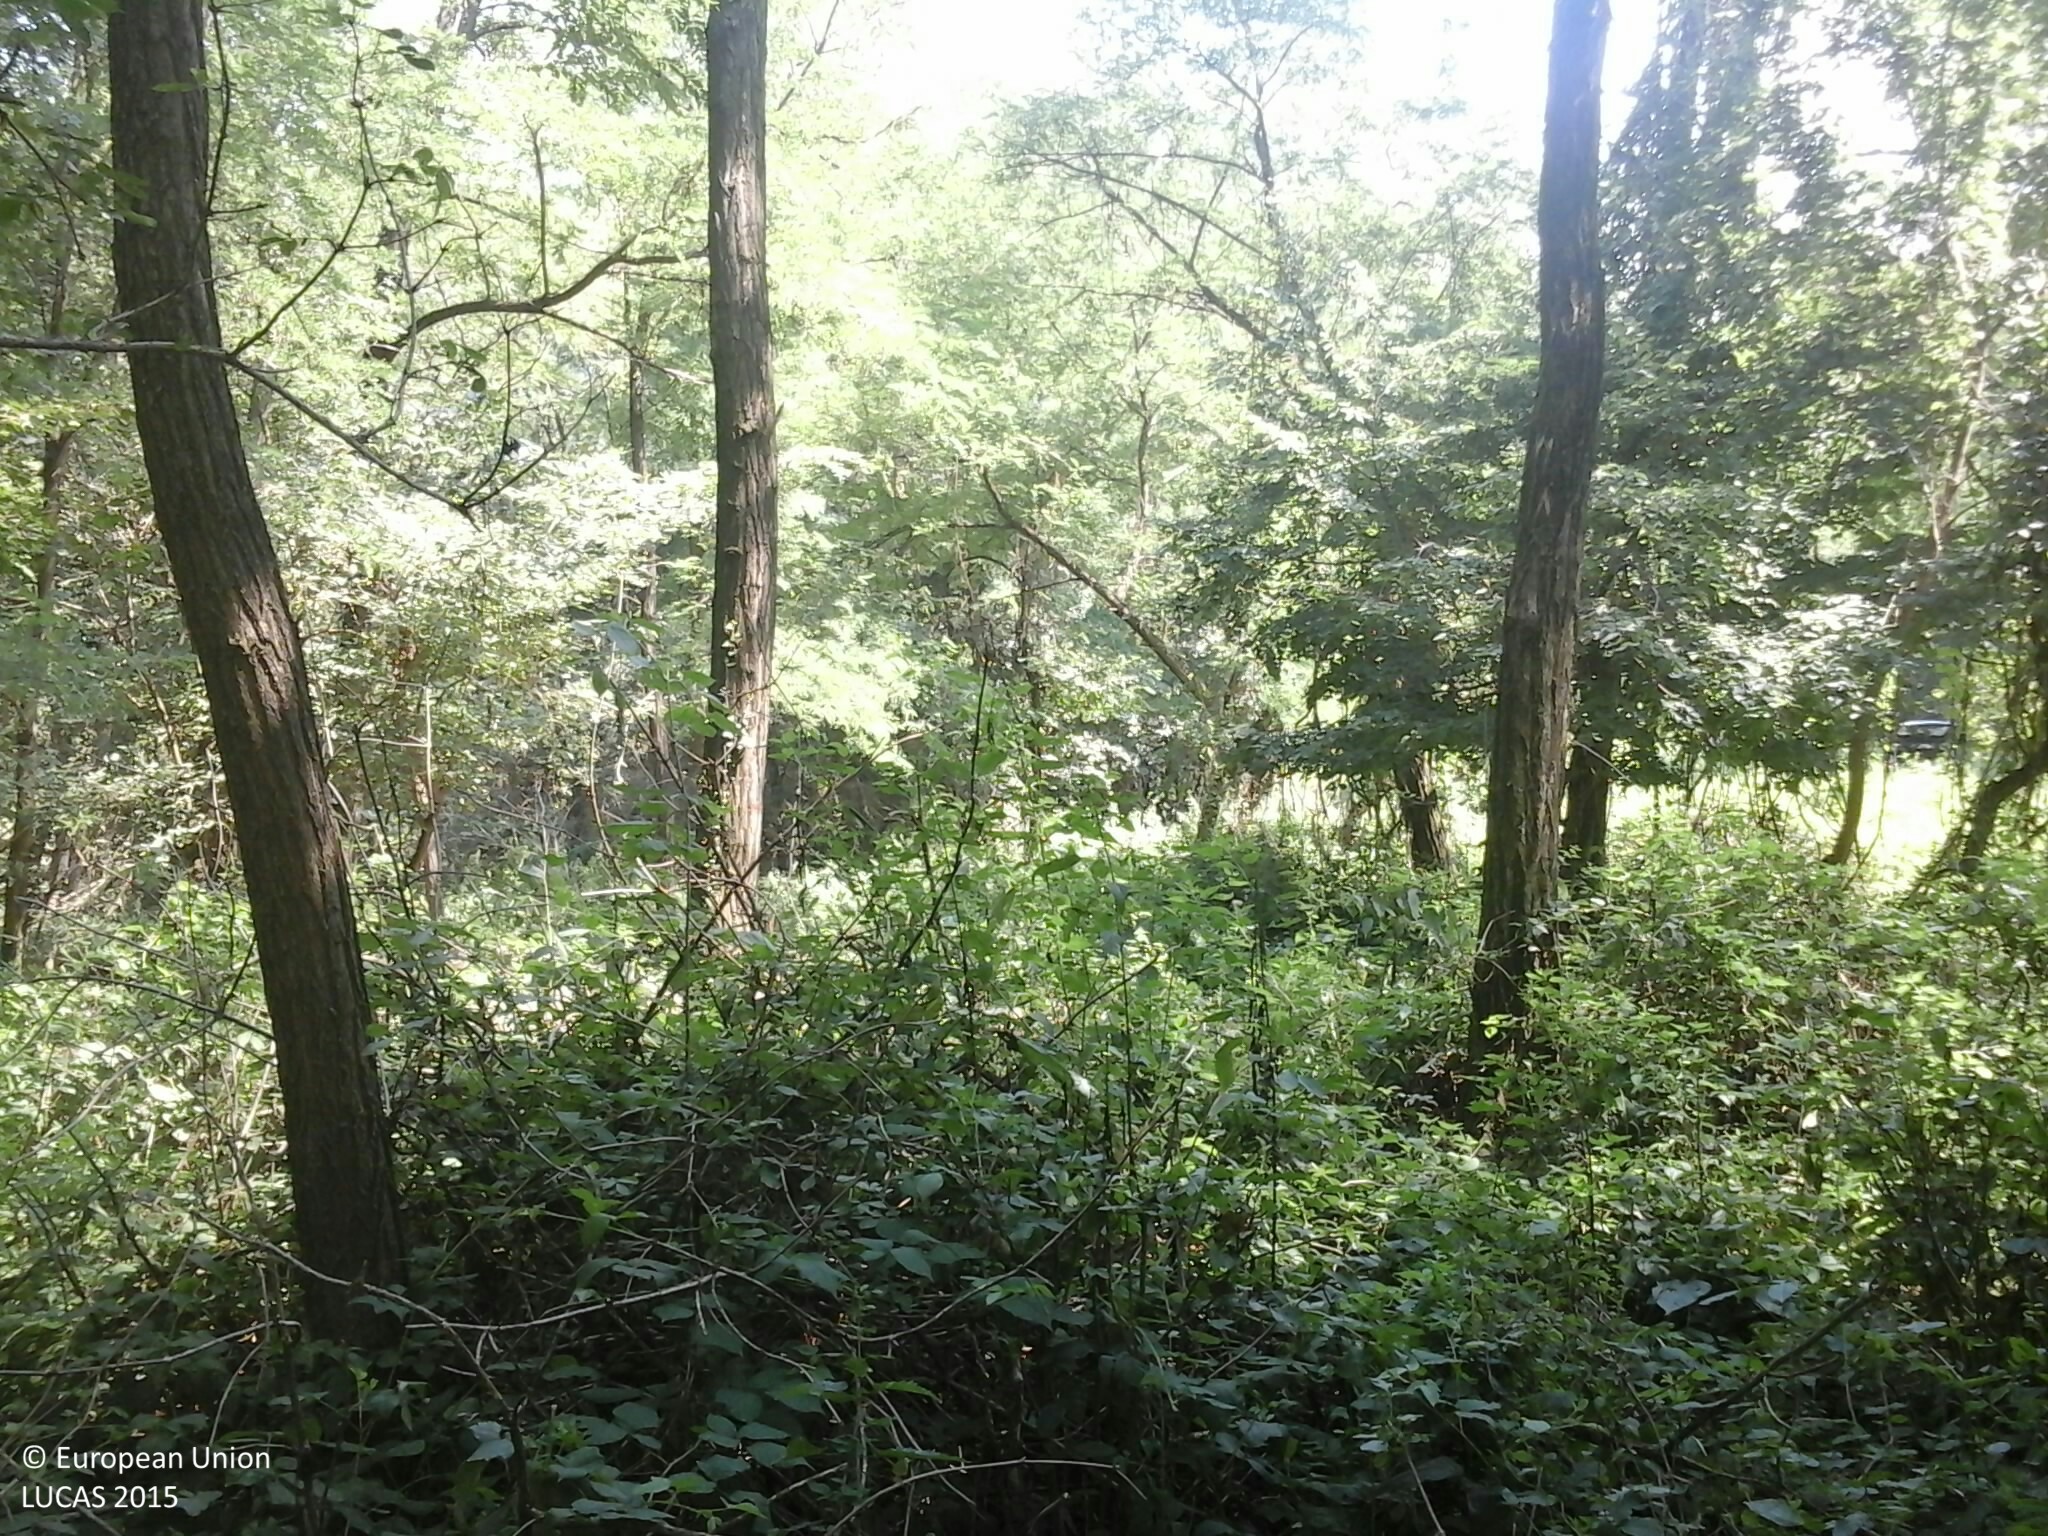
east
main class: Woodland
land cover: Broadleaved woodland
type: mesophytic deciduous forest
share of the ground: > 75 %
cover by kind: broadleaved forest trees 100 %
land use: Forestry
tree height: > 5 m
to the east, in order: Broadleaved woodland; Shruby margins; Tracks; Shruby margins; Broadleaved woodland; Tracks; Grassland without tree/shrub cover
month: August
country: HU
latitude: 46.1722
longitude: 18.0762
